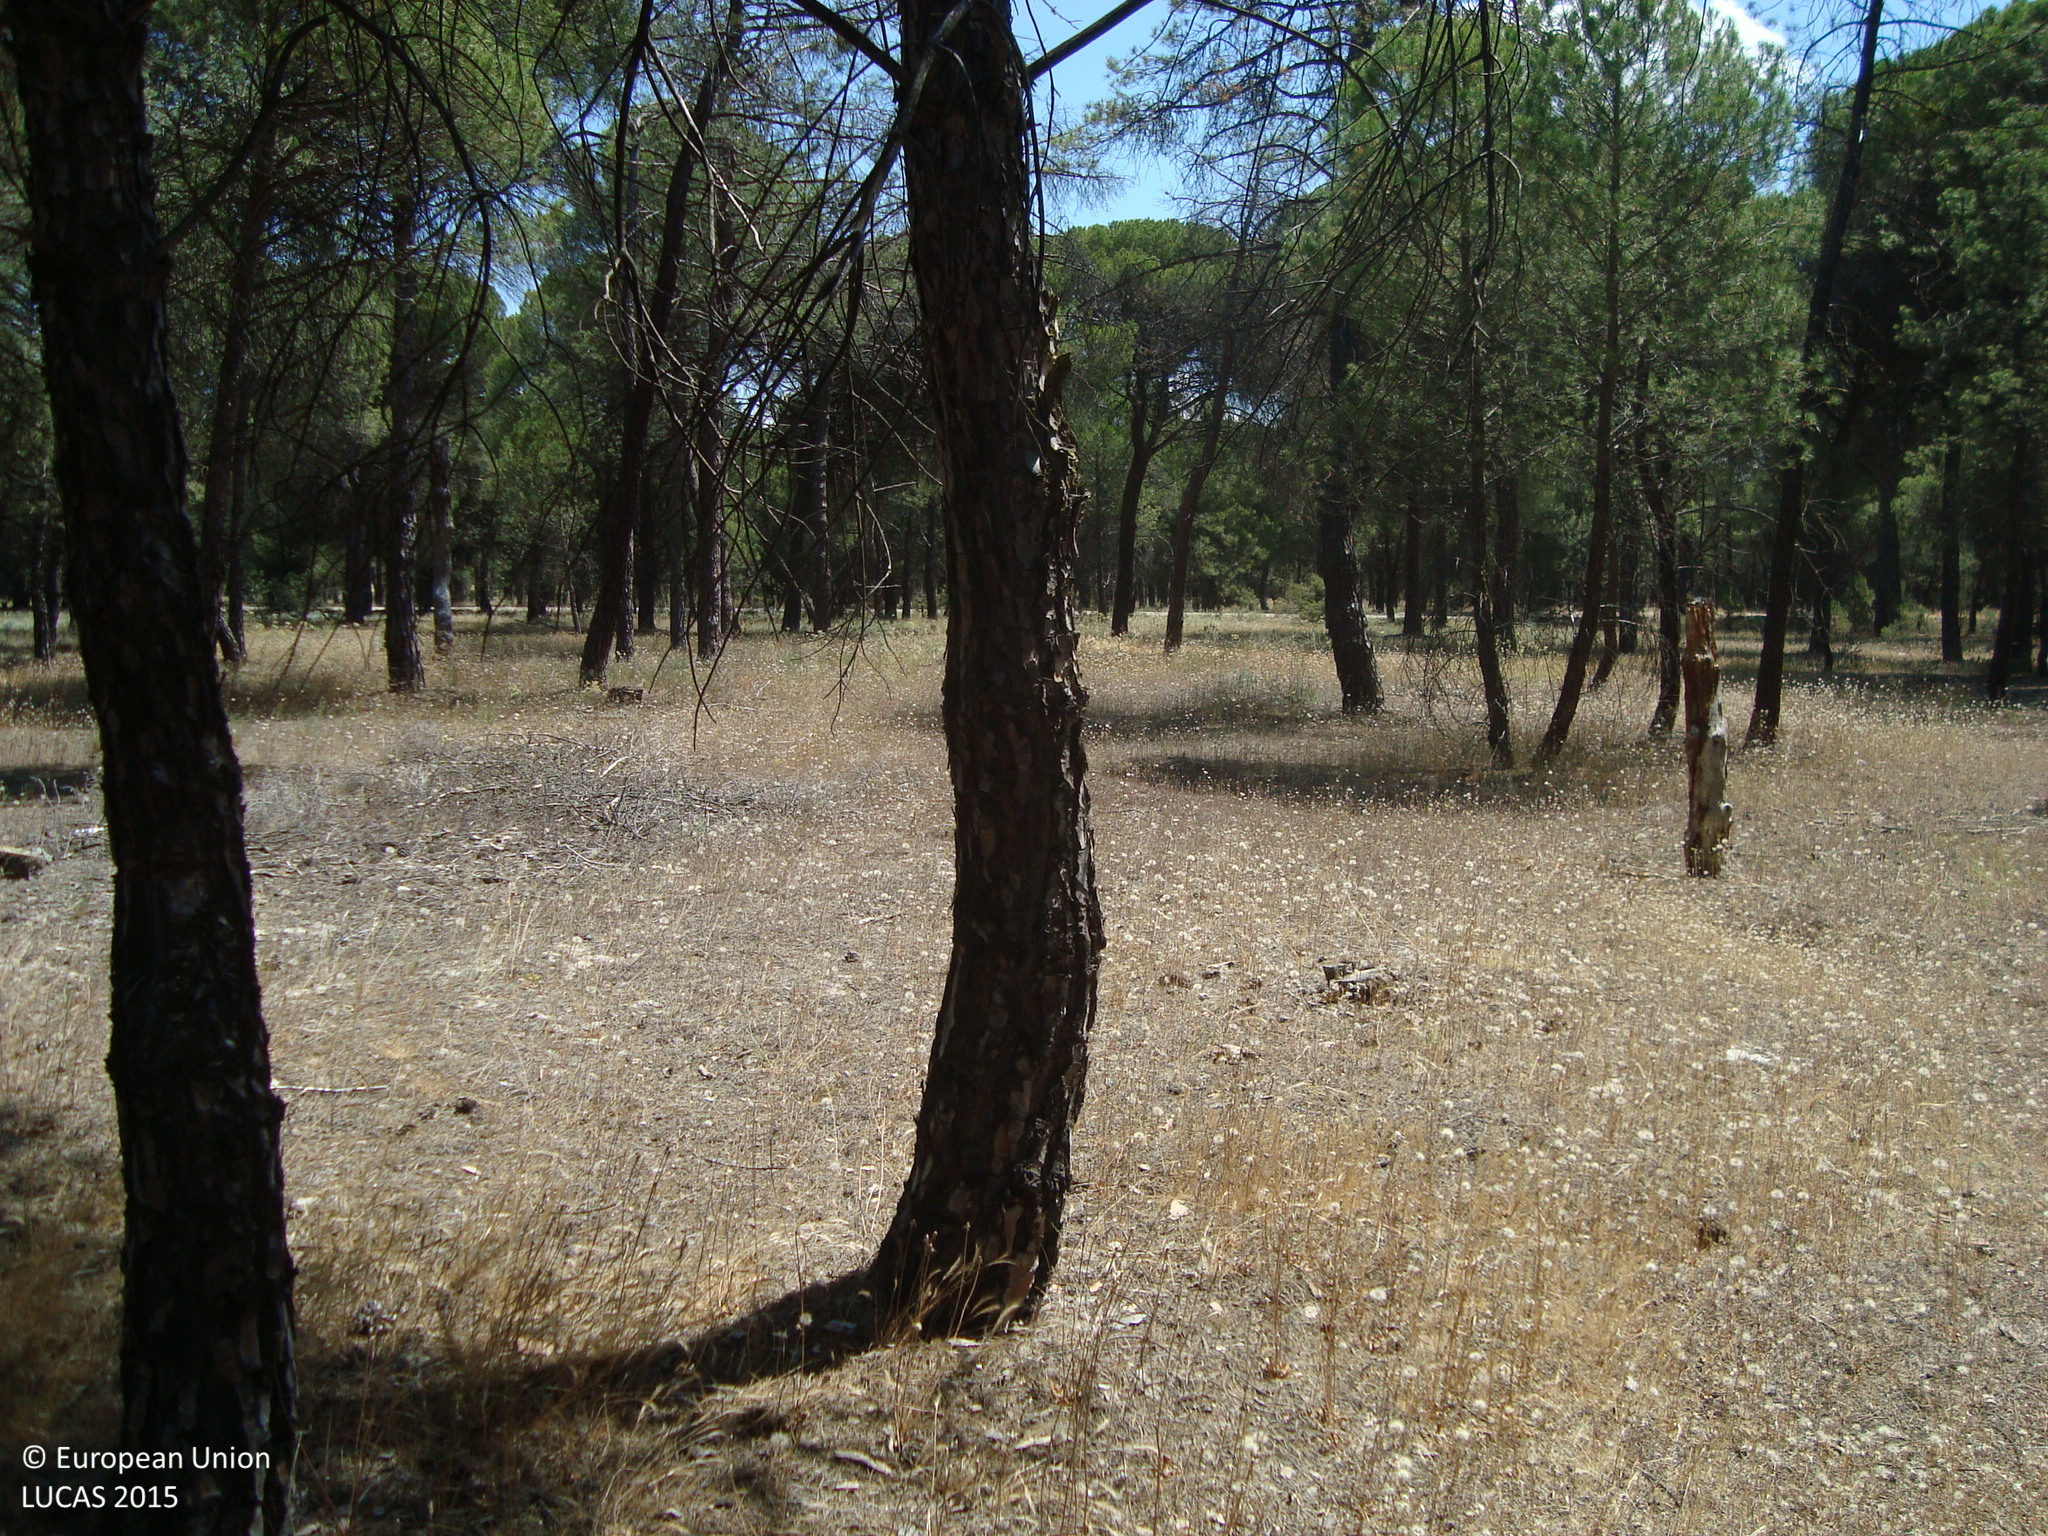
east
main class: Woodland
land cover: Pine dominated coniferous woodland
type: coniferous forest of the mediterranean region
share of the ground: 50 - 75 %
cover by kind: coniferous forest trees 60 %, herbaceous plants 30 %, unconsolidated bare surface 10 %
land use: Forestry
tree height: > 5 m
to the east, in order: Pine dominated coniferous woodland; Paved roads, cycling and walking lanes; Pine dominated coniferous woodland
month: June
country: ES
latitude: 41.4916
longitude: -4.6428
